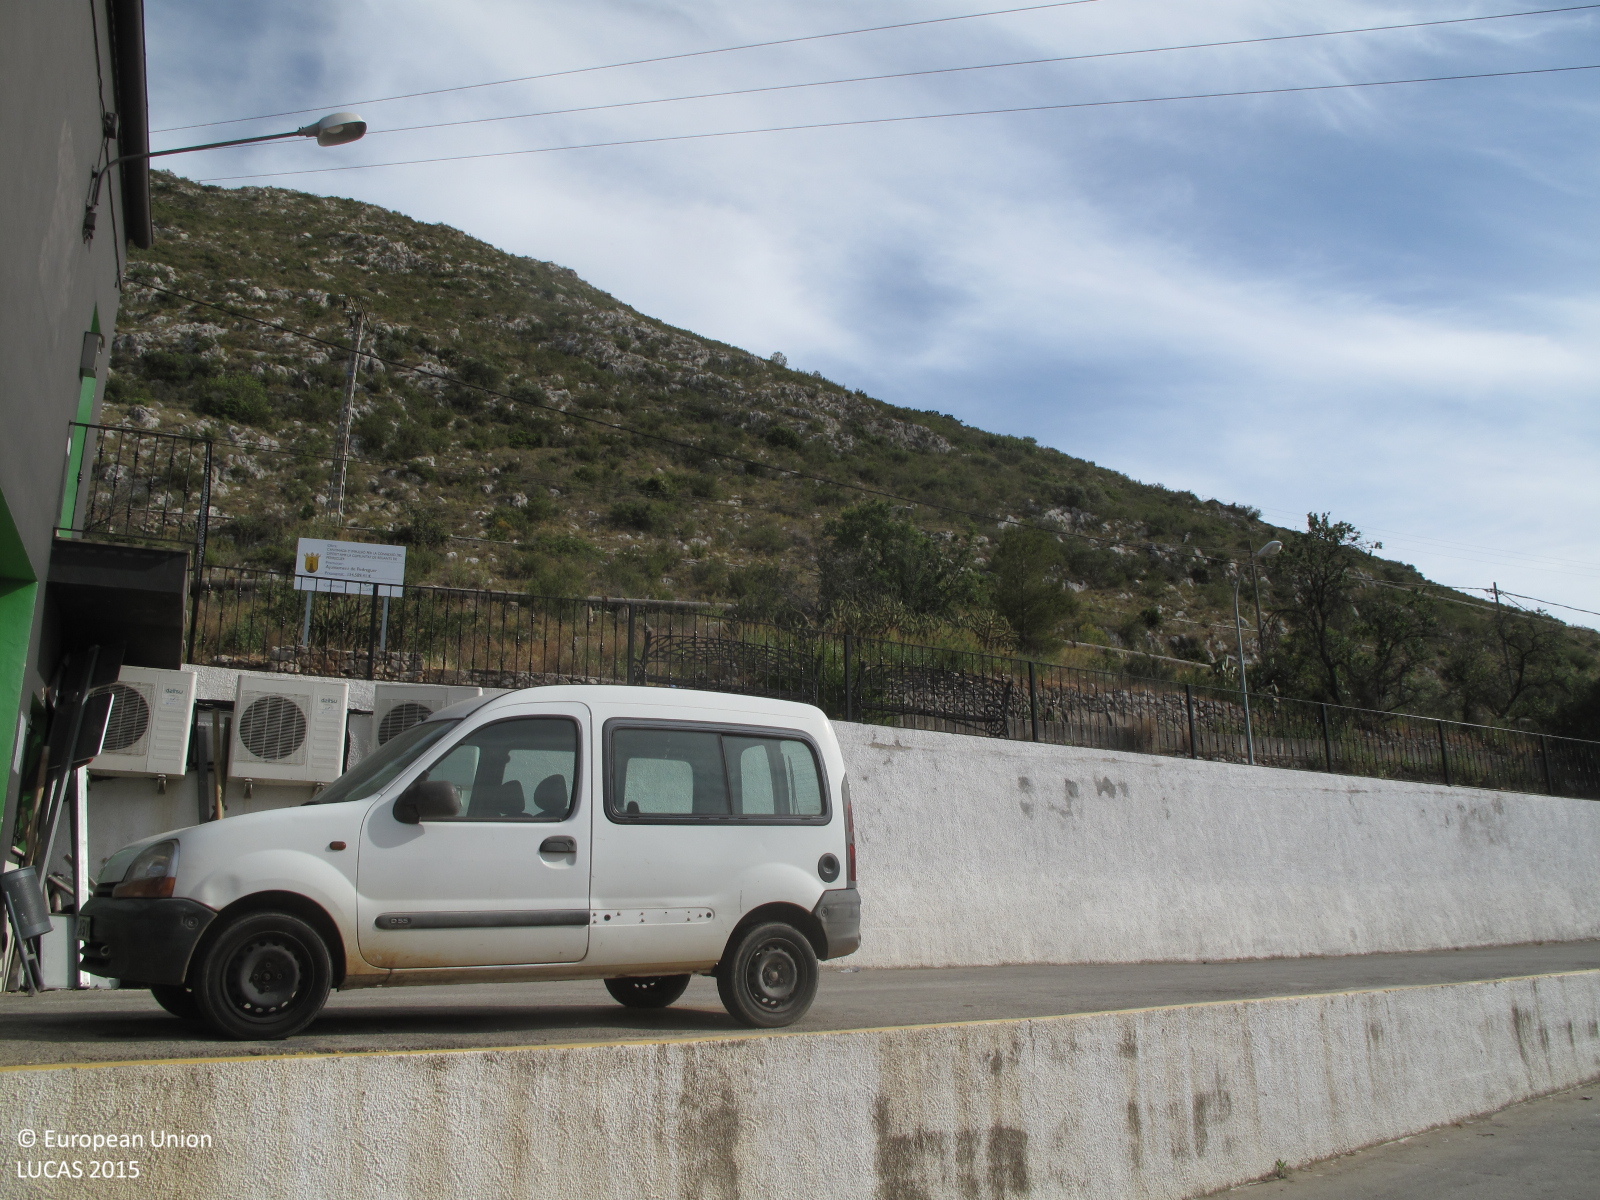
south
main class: Grassland
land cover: Grassland with sparse tree/shrub cover
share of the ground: > 75 %
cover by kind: herbaceous plants 95 %, broadleaved forest trees 5 %
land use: Residential
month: May
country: ES
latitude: 38.7920
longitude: 0.0296
